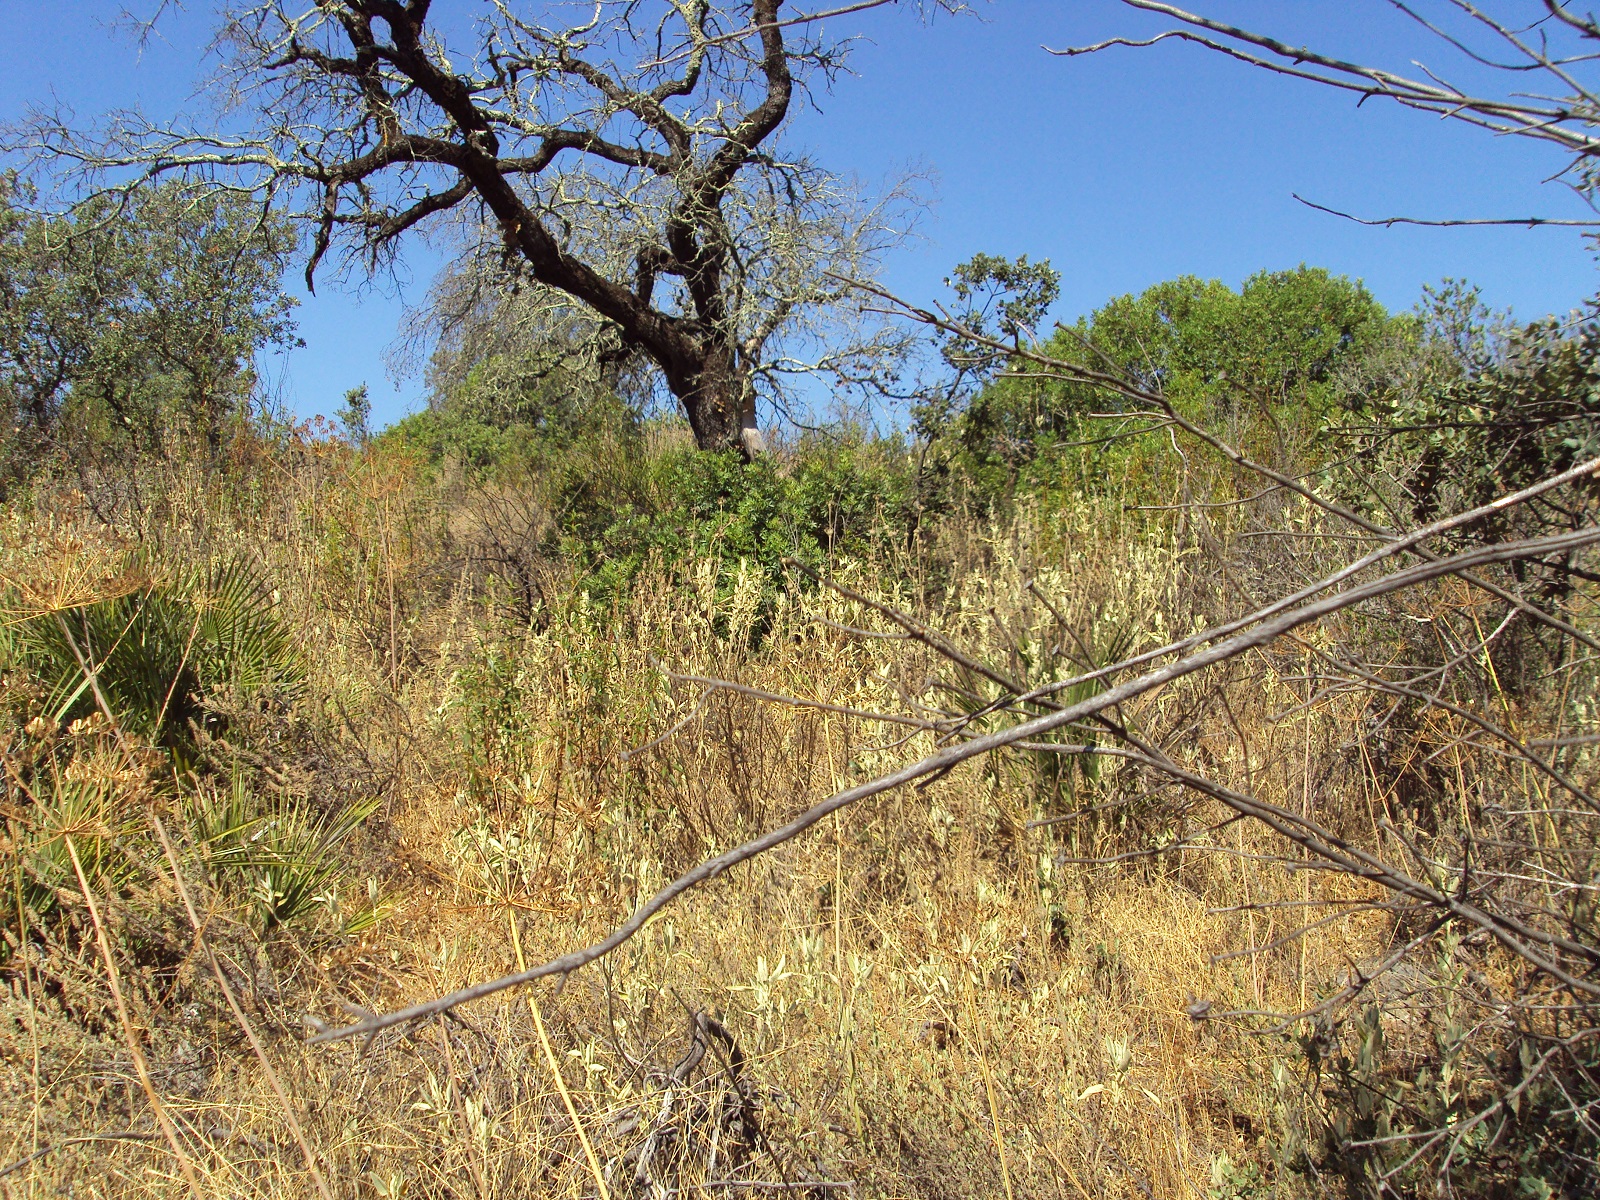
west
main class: Woodland
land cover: Broadleaved woodland
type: broadleaved evergreen forest
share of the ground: 25 - 50 %
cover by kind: shrubs 70 %, broadleaved forest trees 30 %
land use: Semi-natural and natural areas not in use
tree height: < 5 m
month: June
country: ES
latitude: 37.4217
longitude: -6.9113
